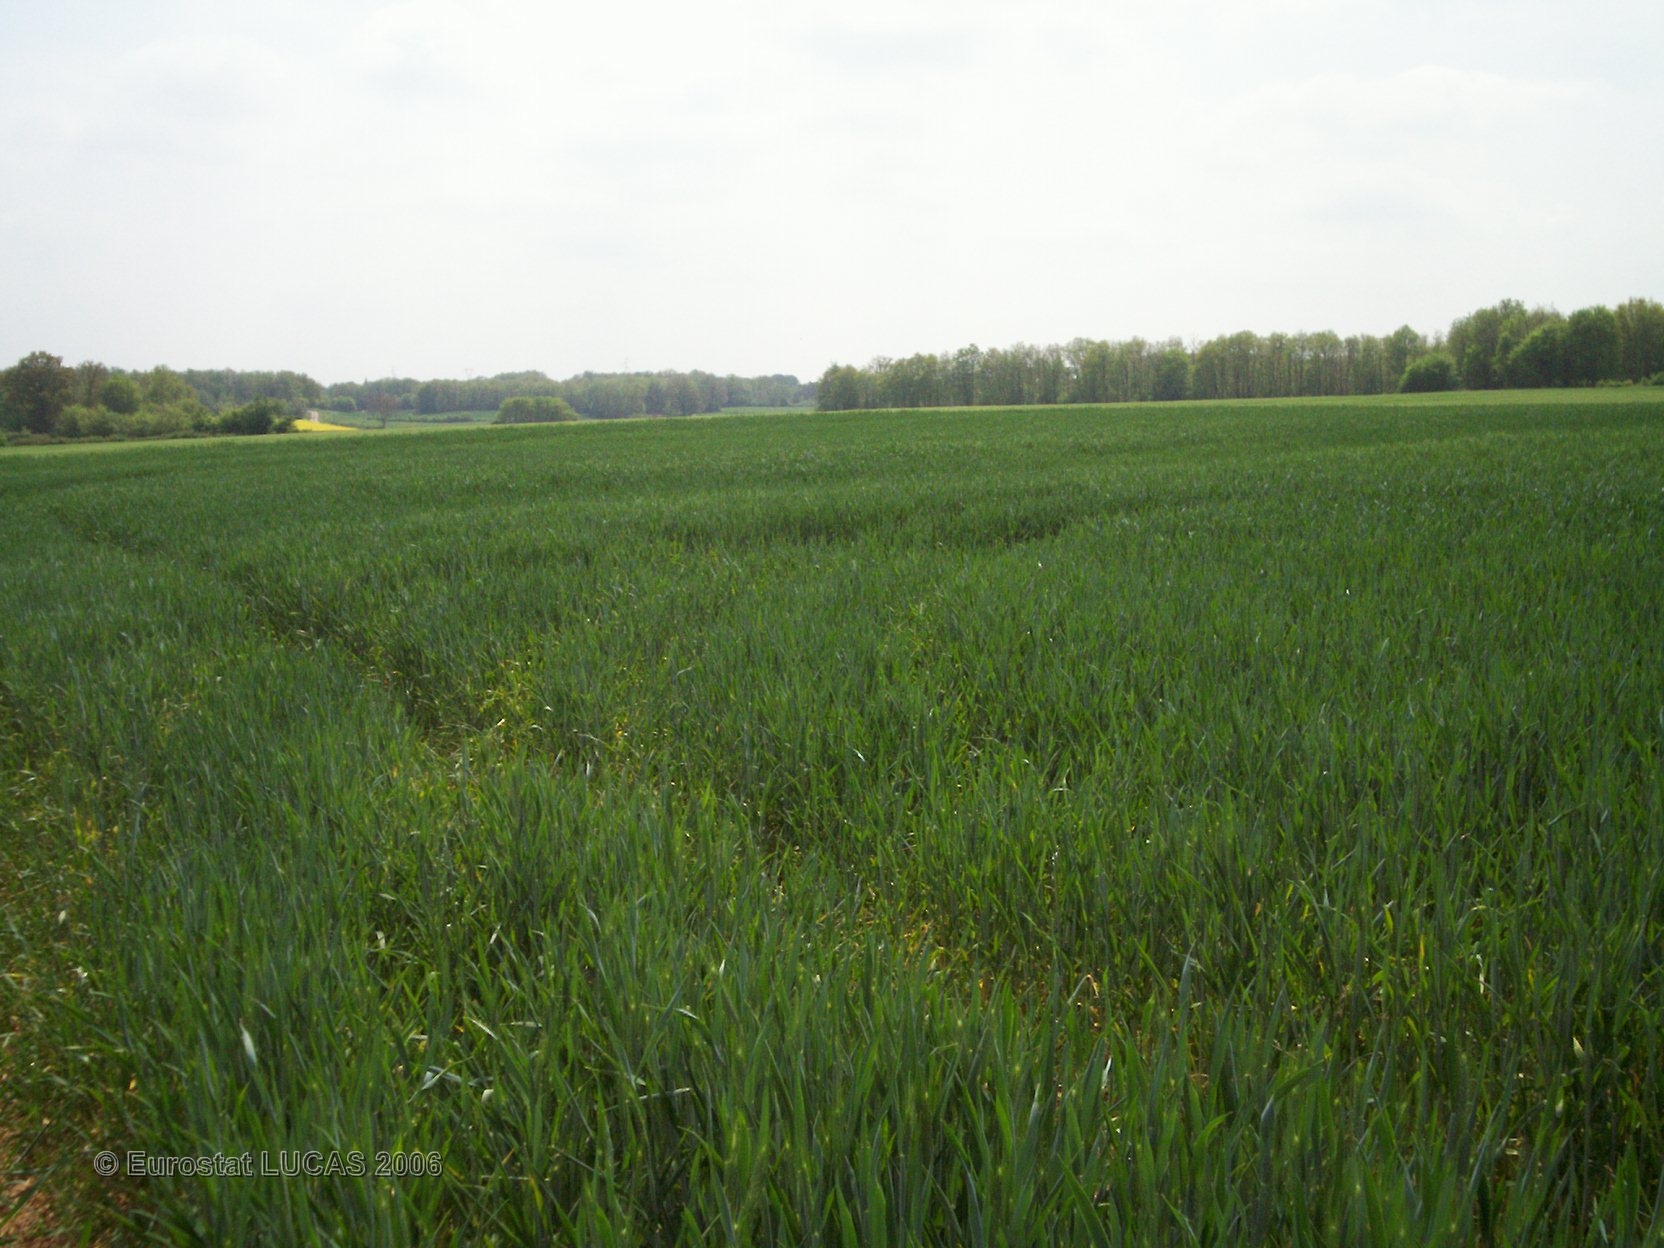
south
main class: Cropland
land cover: Common wheat
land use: Agriculture (excluding fallow land and kitchen gardens)
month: May
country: FR
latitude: 46.6559
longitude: 0.9557
